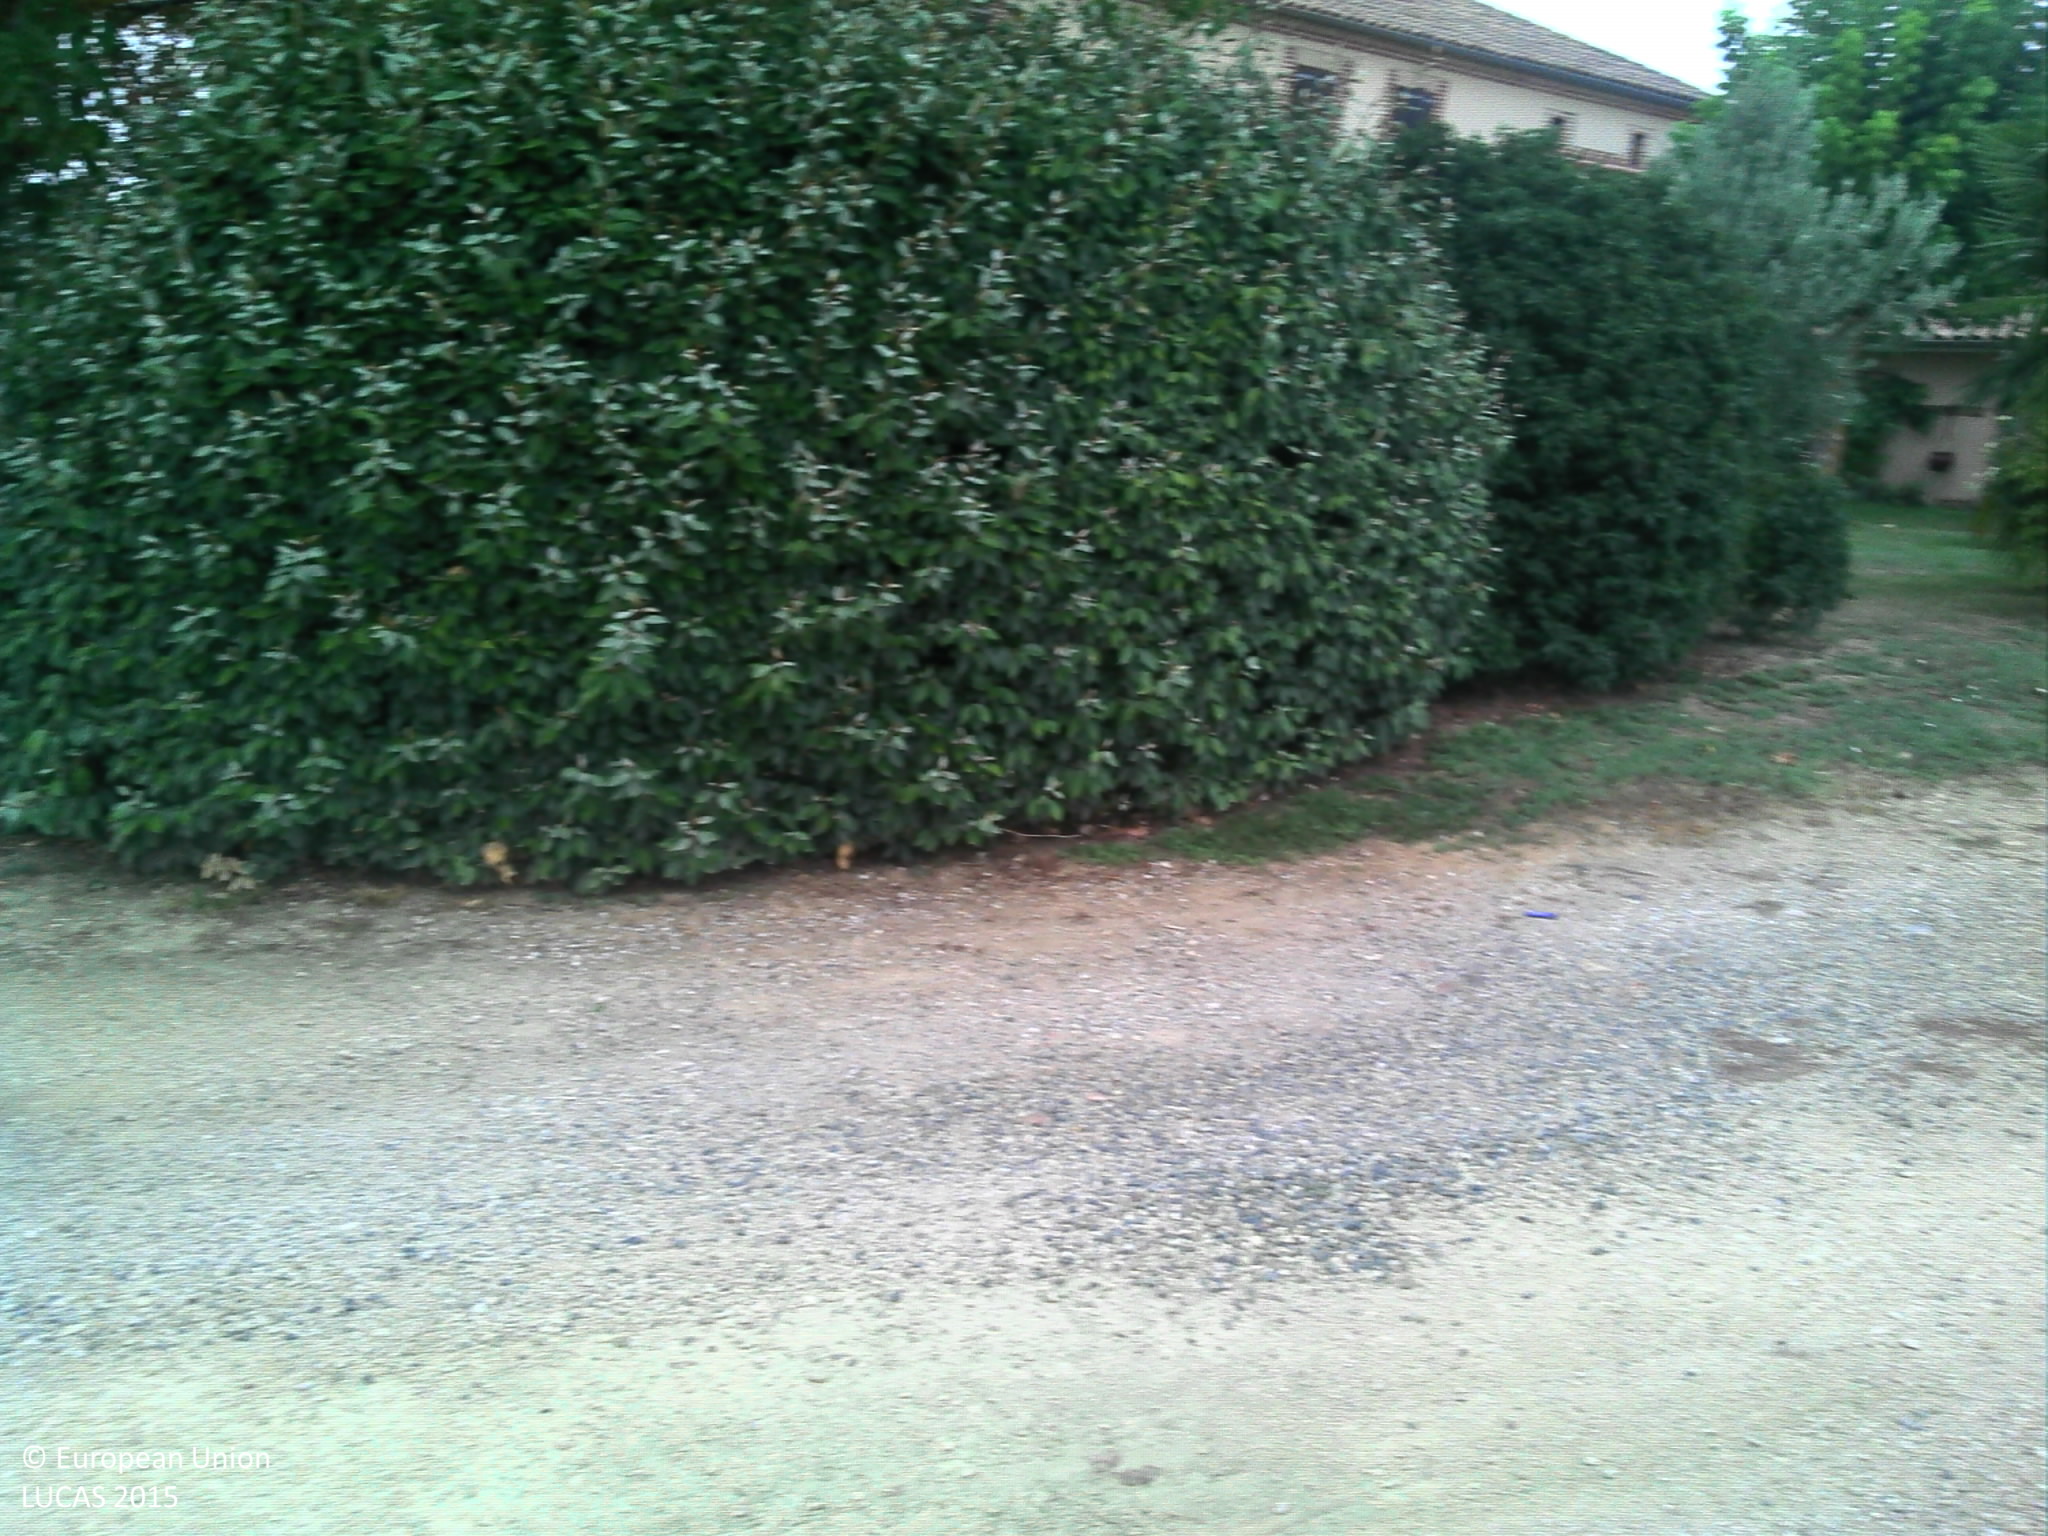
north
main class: Grassland
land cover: Grassland with sparse tree/shrub cover
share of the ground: > 75 %
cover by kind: herbaceous plants 95 %, broadleaved forest trees 5 %
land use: Residential
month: August
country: FR
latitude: 43.9096
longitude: 1.2712
